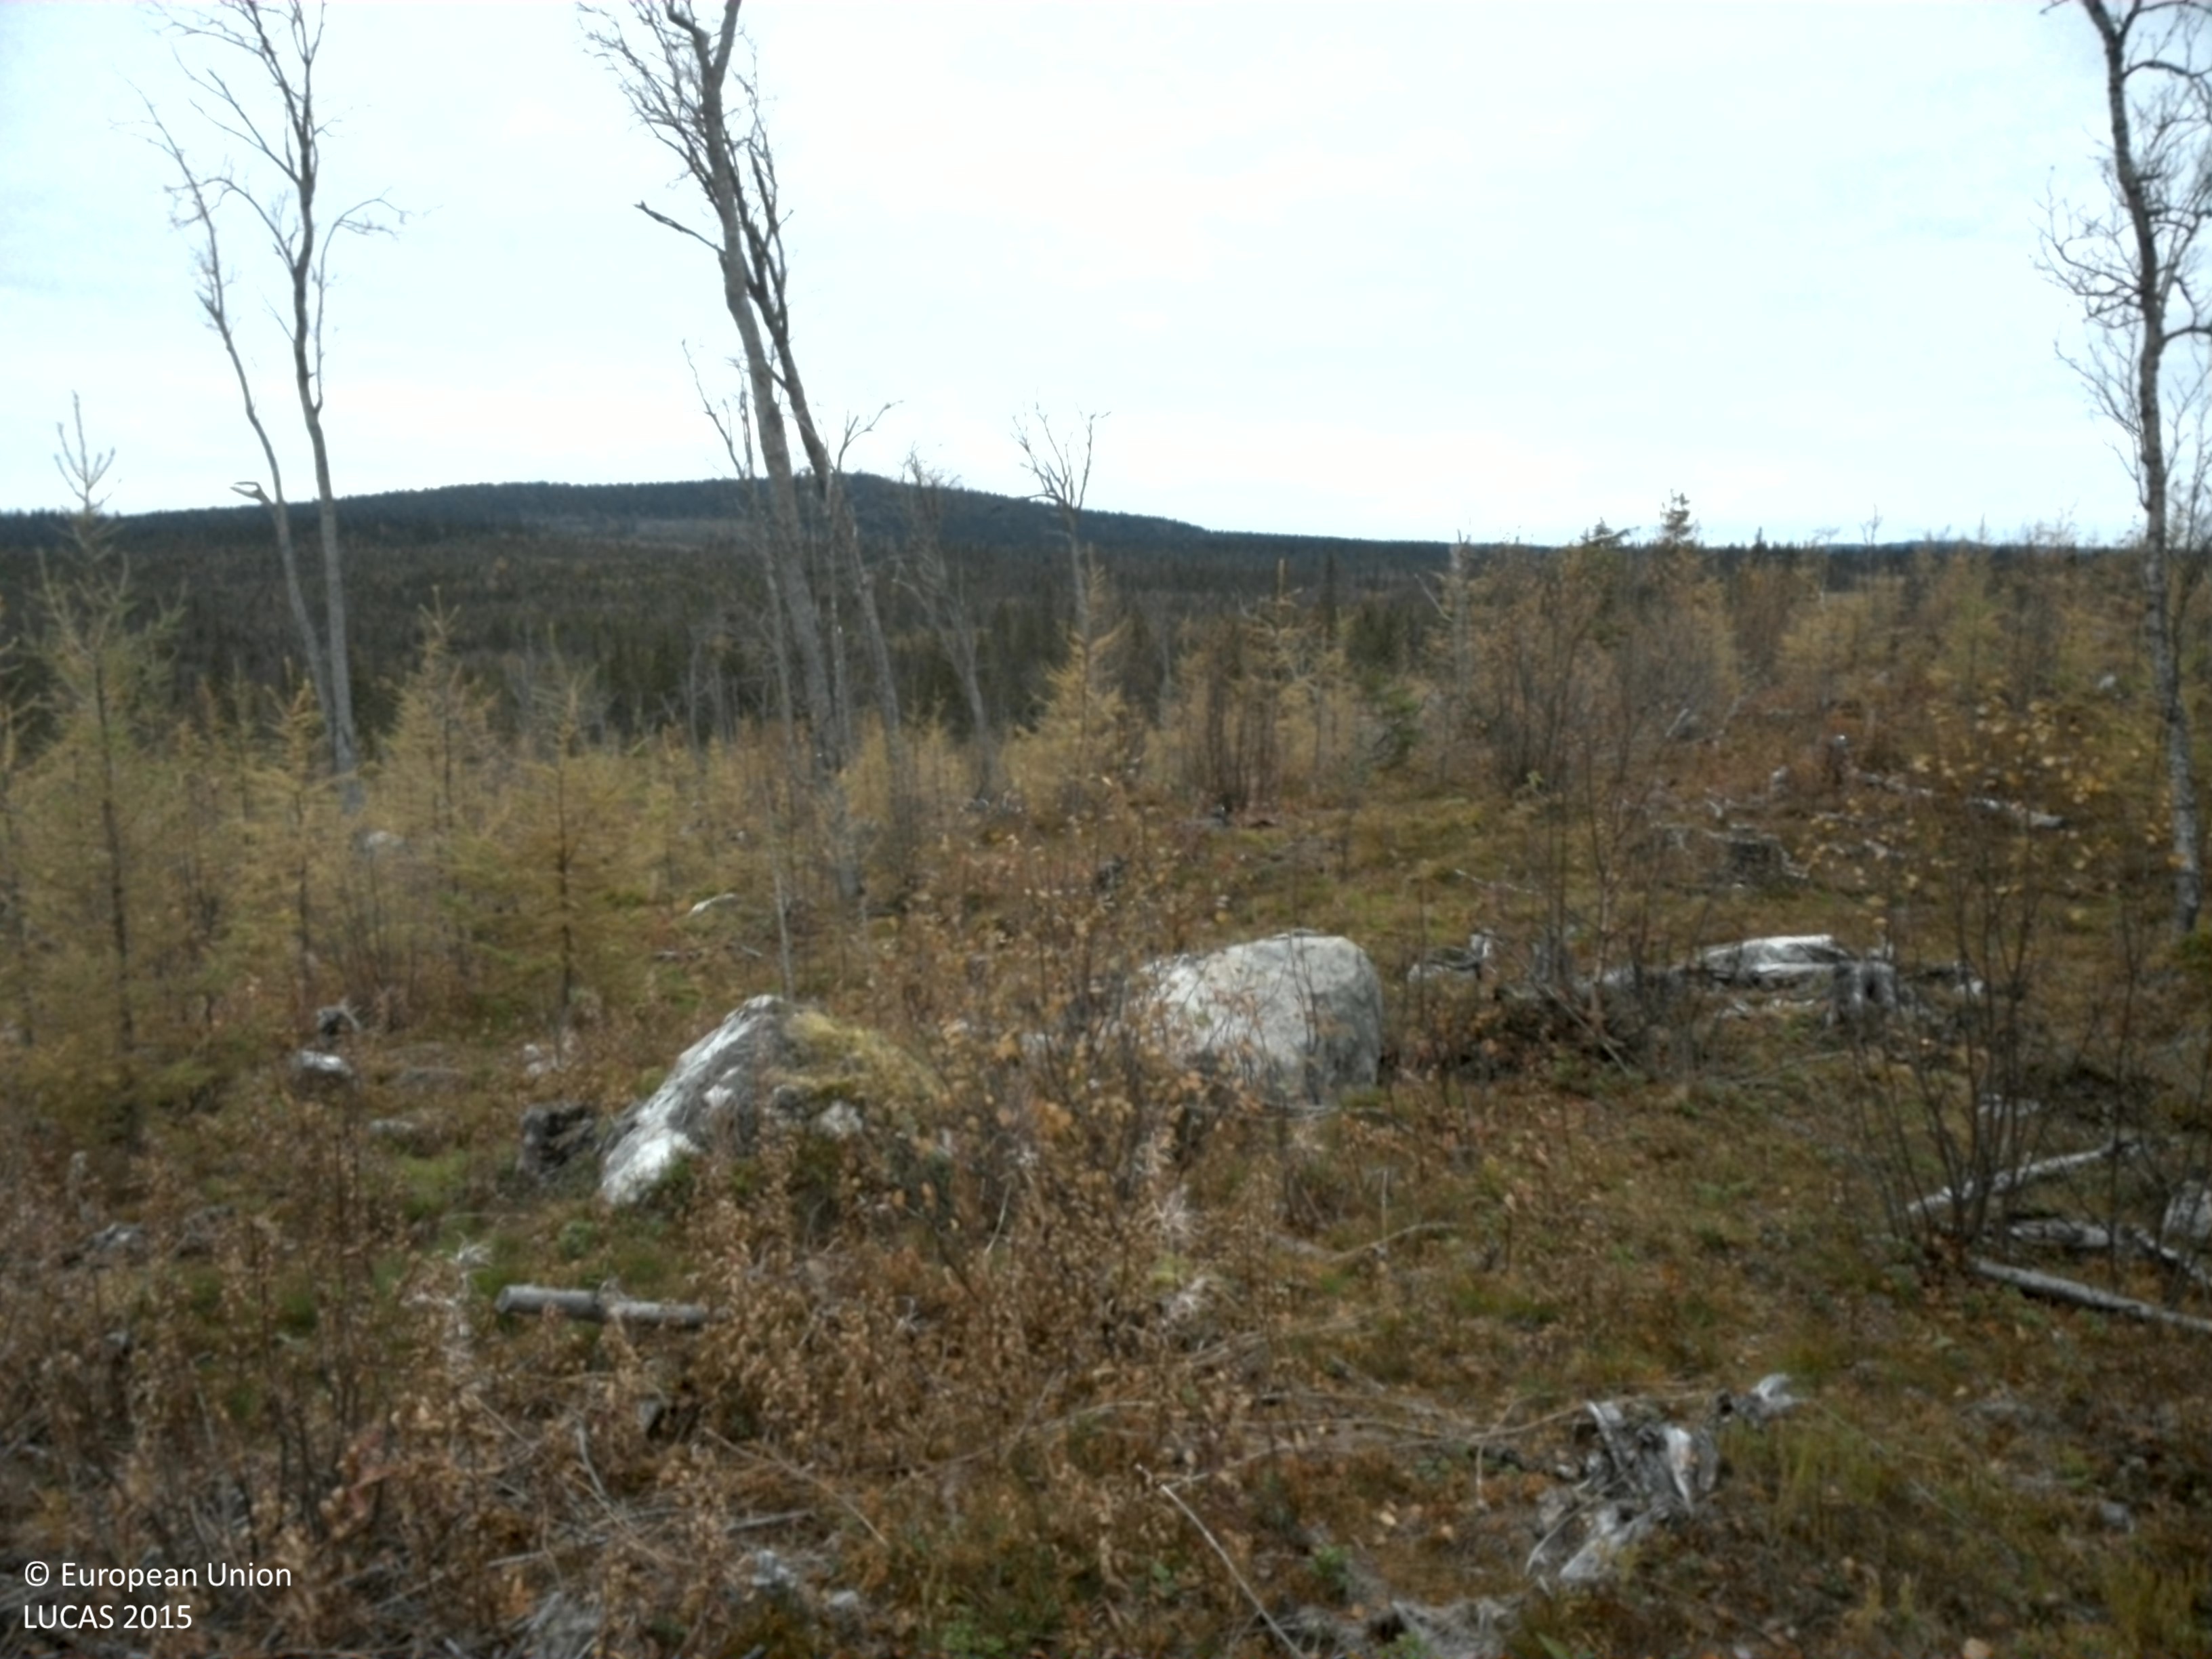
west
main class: Woodland
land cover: Other mixed woodland
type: exotic forest
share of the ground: 10 - 25 %
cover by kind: herbaceous plants 55 %, shrubs 20 %, lichens and mosses 15 %, coniferous forest trees 5 %, broadleaved forest trees 5 %
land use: Forestry
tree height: < 5 m
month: October
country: SE
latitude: 64.9560
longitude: 16.8876
